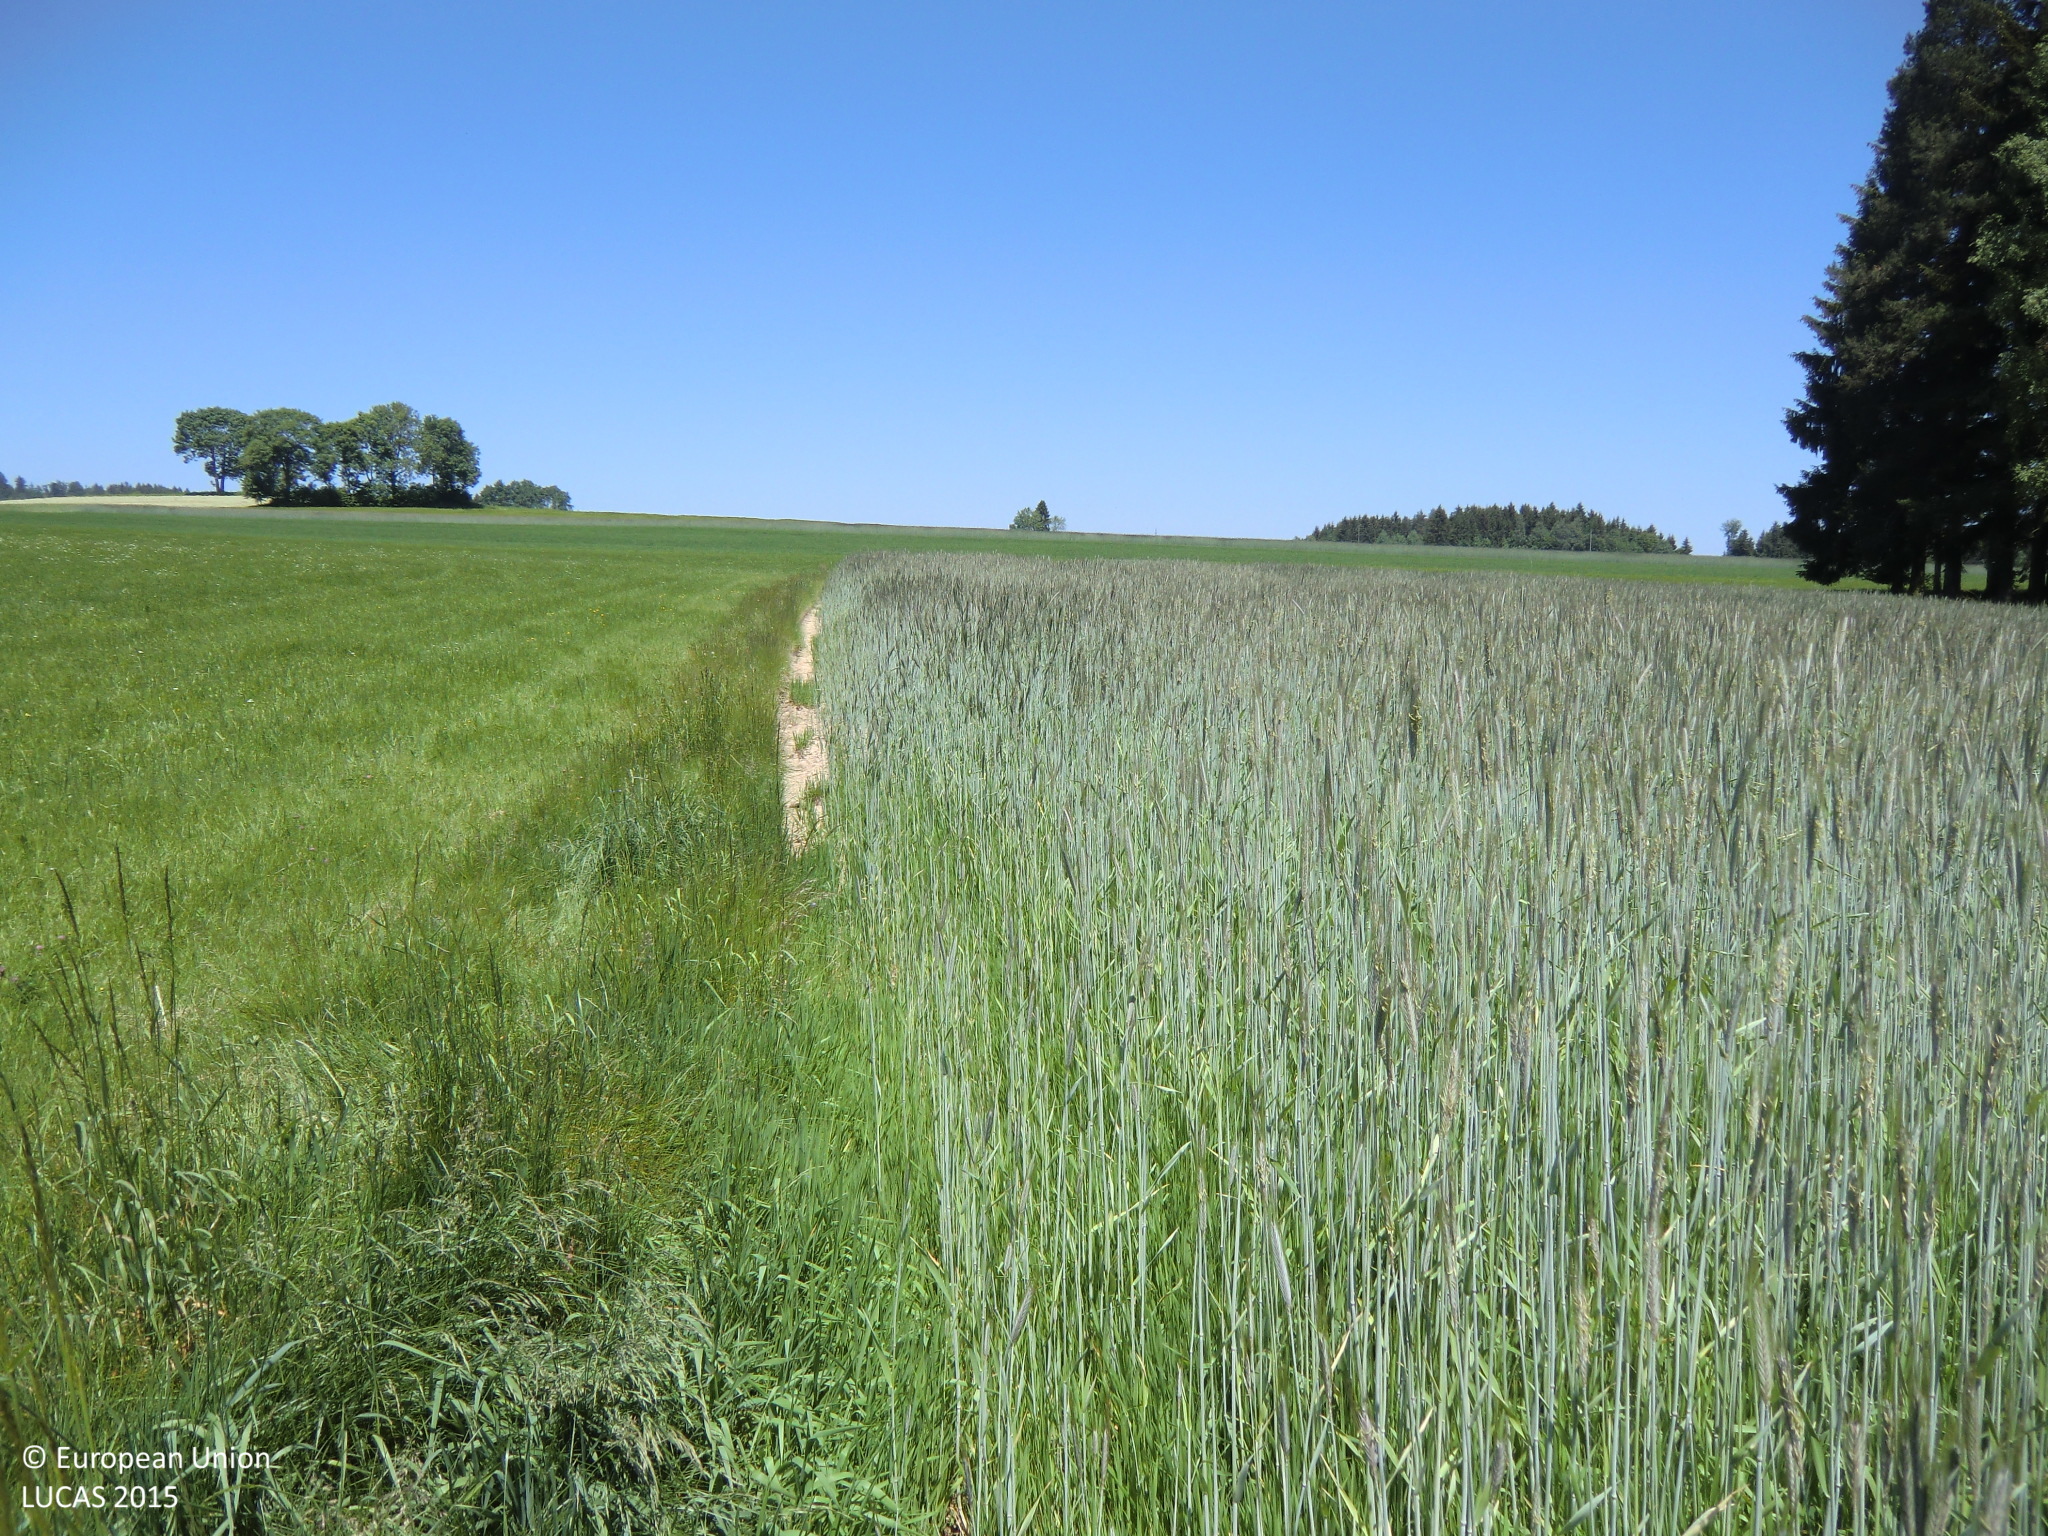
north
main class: Cropland
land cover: Rye
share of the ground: > 75 %
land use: Agriculture (excluding fallow land and kitchen gardens)
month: June
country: AT
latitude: 48.6018
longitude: 14.4623
